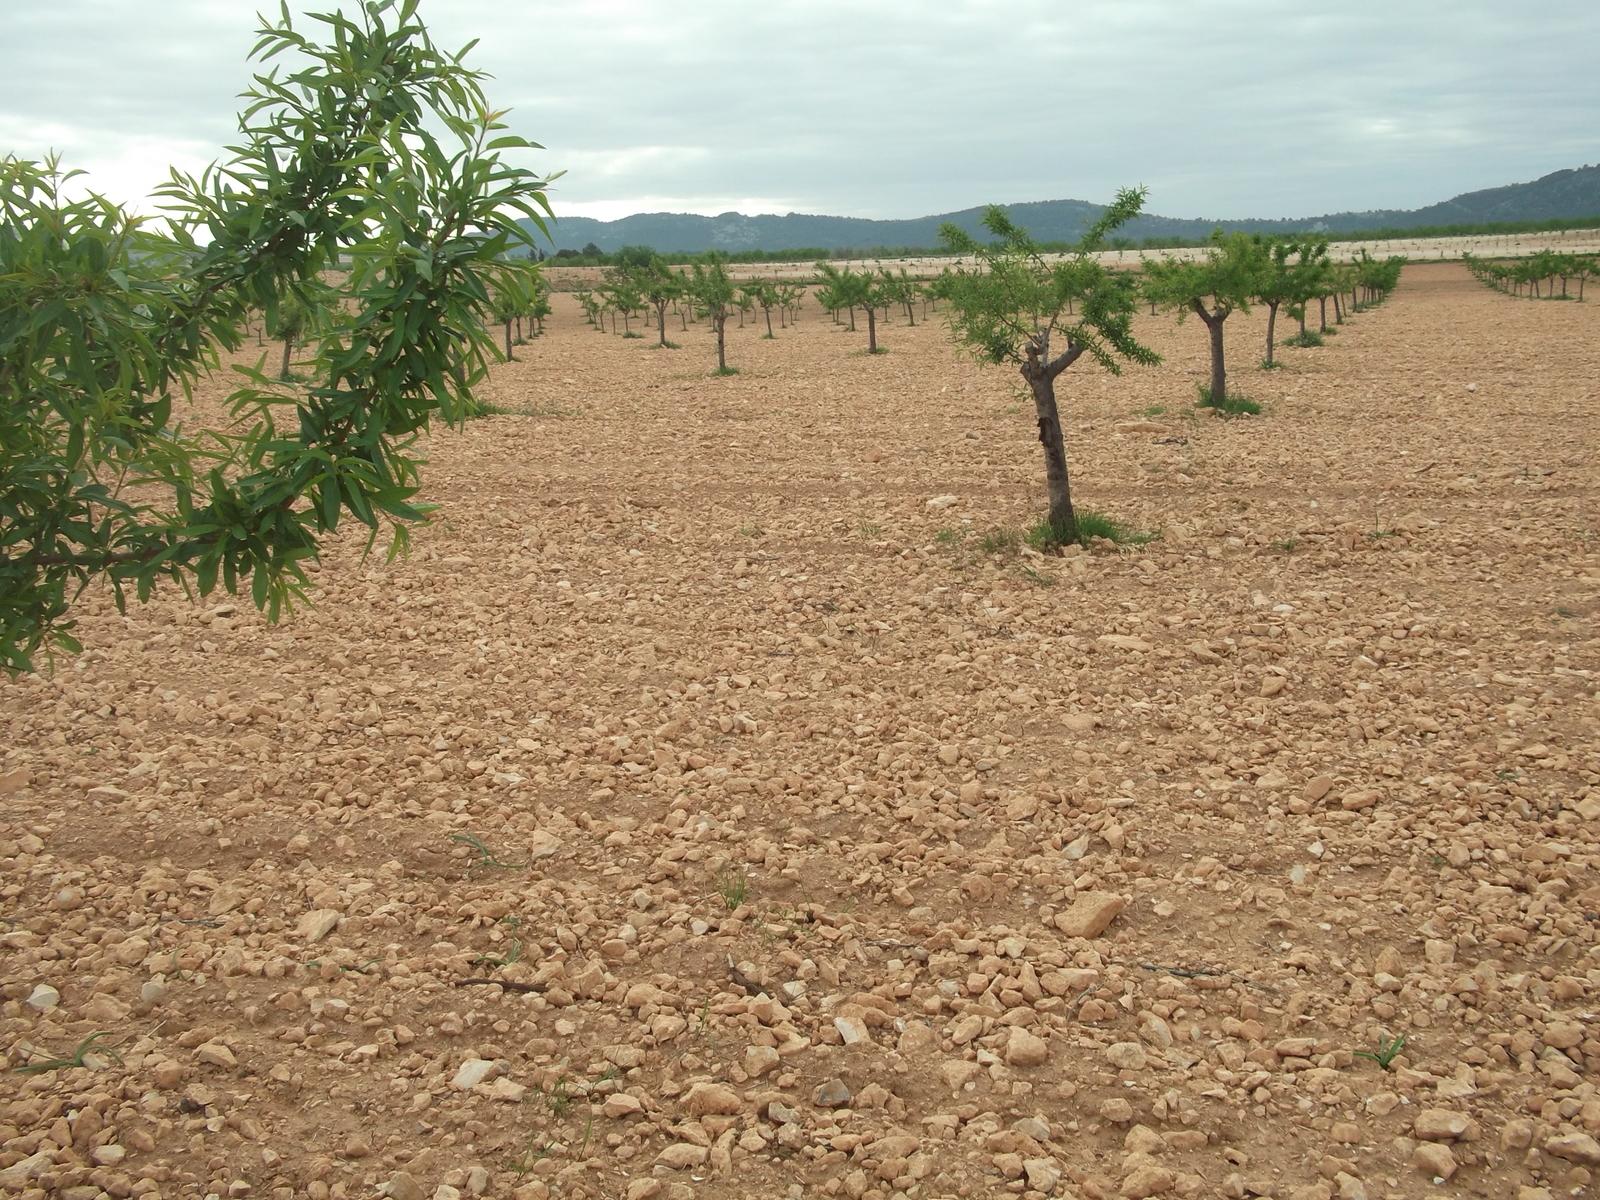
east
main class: Cropland
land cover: Nuts trees
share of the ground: < 10 %
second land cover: Other bare soil
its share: > 75 %
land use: Agriculture (excluding fallow land and kitchen gardens)
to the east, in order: Nuts trees; Other bare soil; Grass margins; Nuts trees
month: April
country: ES
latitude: 38.1038
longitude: -1.5397
